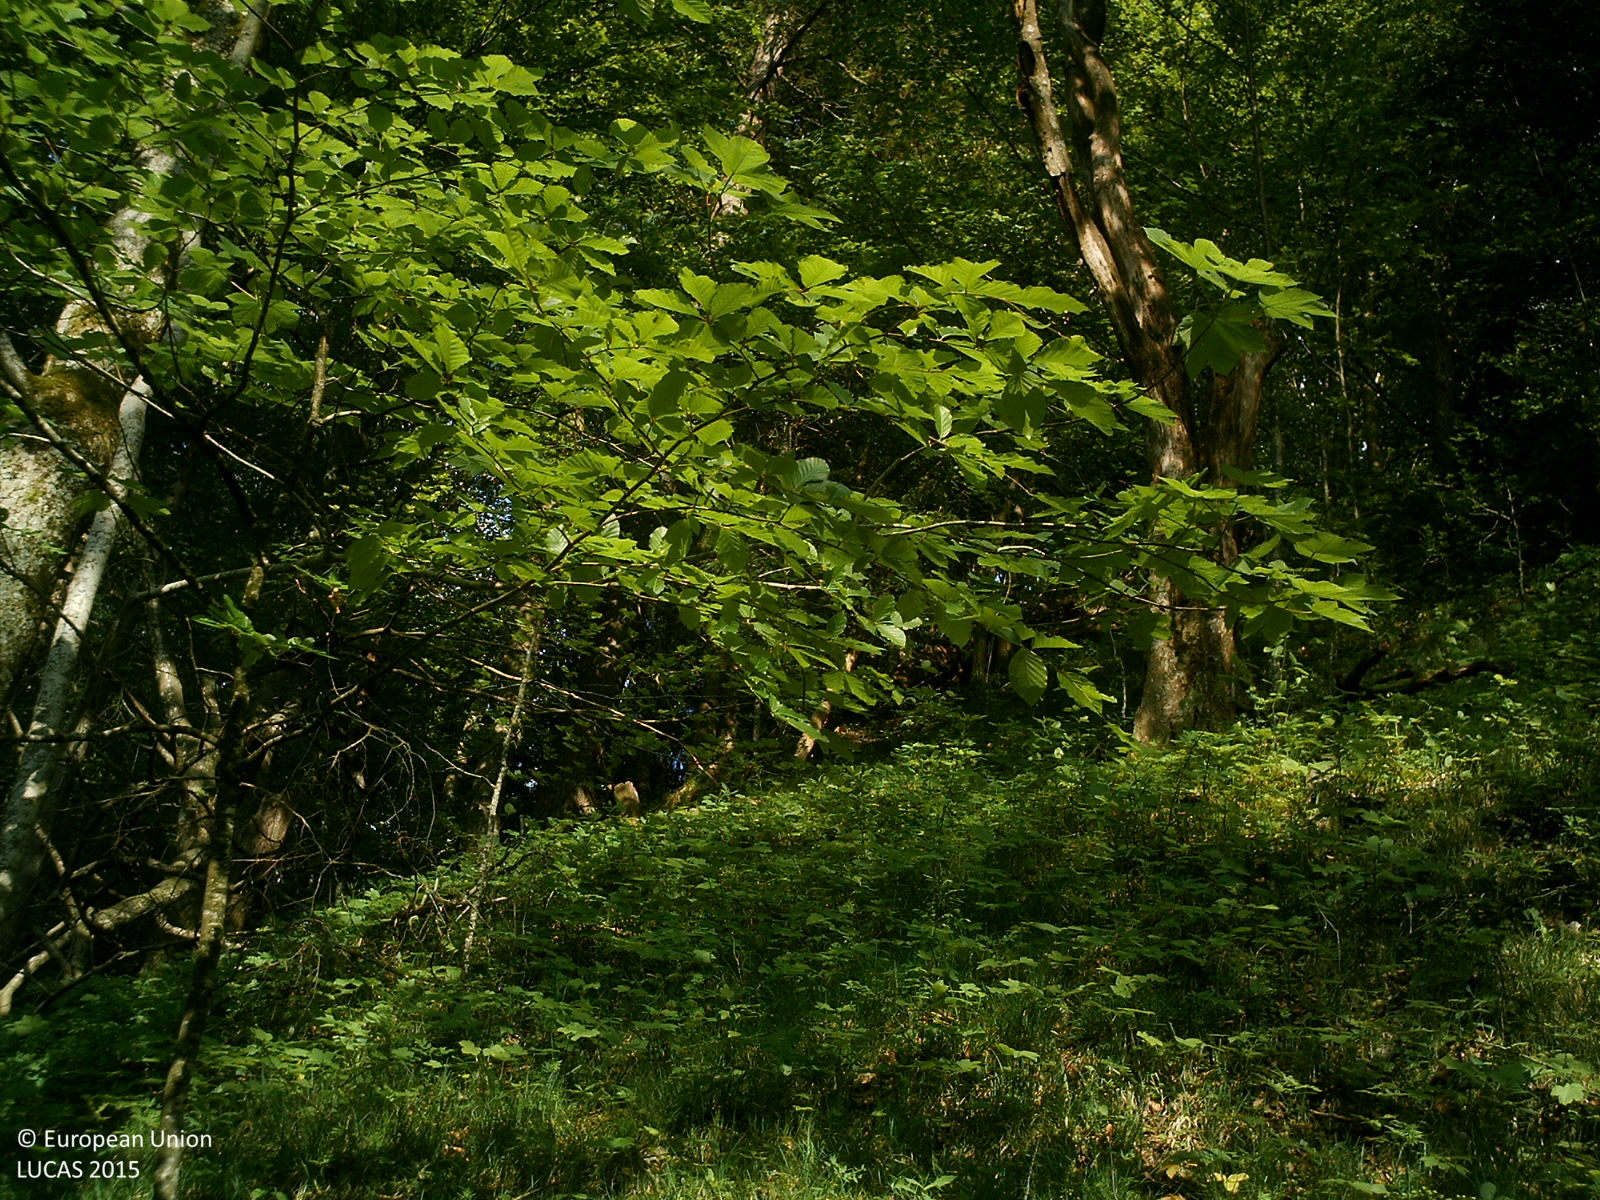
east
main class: Woodland
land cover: Other mixed woodland
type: mountainous beech forest
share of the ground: > 75 %
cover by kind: broadleaved forest trees 60 %, coniferous forest trees 35 %, shrubs 5 %
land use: Forestry
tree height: > 5 m
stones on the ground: < 10 %
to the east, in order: Other mixed woodland; Shrubland with sparse tree cover; Tracks; Grassland without tree/shrub cover; Fences; Grassland without tree/shrub cover; Rivers and streams; Single bushes/trees
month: May
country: AT
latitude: 47.8877
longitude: 14.2925
